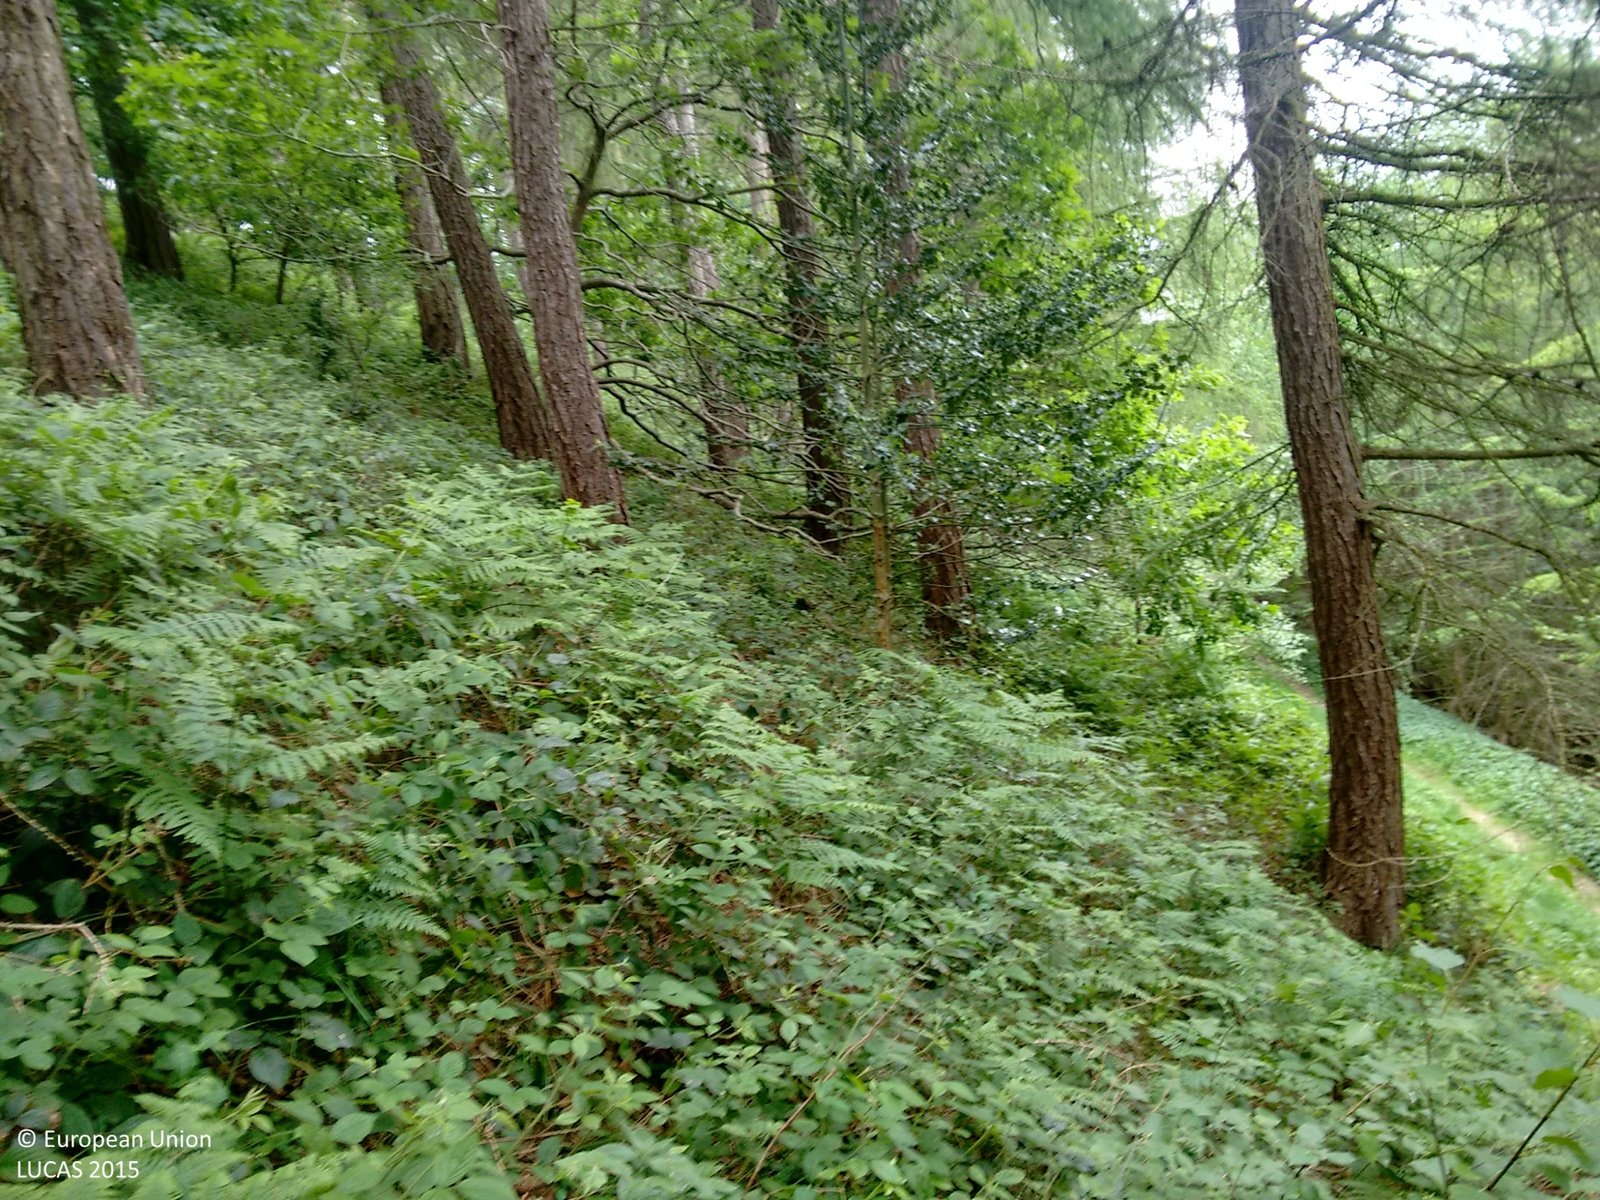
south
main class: Woodland
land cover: Pine dominated mixed woodland
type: exotic forest
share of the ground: > 75 %
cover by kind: coniferous forest trees 70 %, broadleaved forest trees 30 %
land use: Forestry
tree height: > 5 m
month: June
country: GB
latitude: 54.2712
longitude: -1.0840
